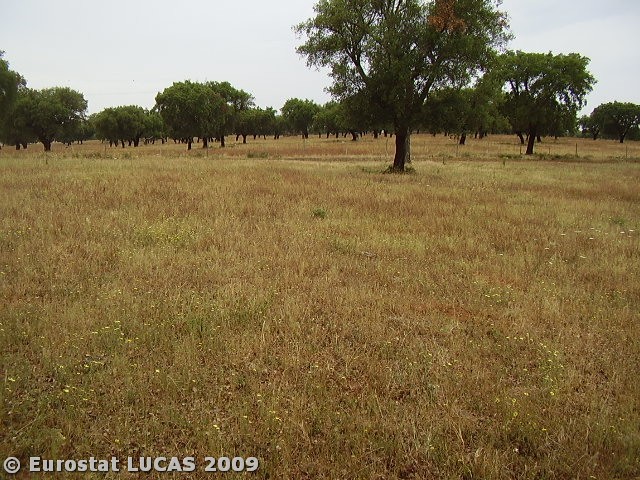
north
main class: Woodland
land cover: Broadleaved woodland
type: broadleaved evergreen forest
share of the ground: < 10 %
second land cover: Temporary grasslands
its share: > 75 %
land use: Forestry
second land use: Agriculture (excluding fallow land and kitchen gardens)
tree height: > 5 m
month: June
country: PT
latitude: 38.4575
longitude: -7.9028
